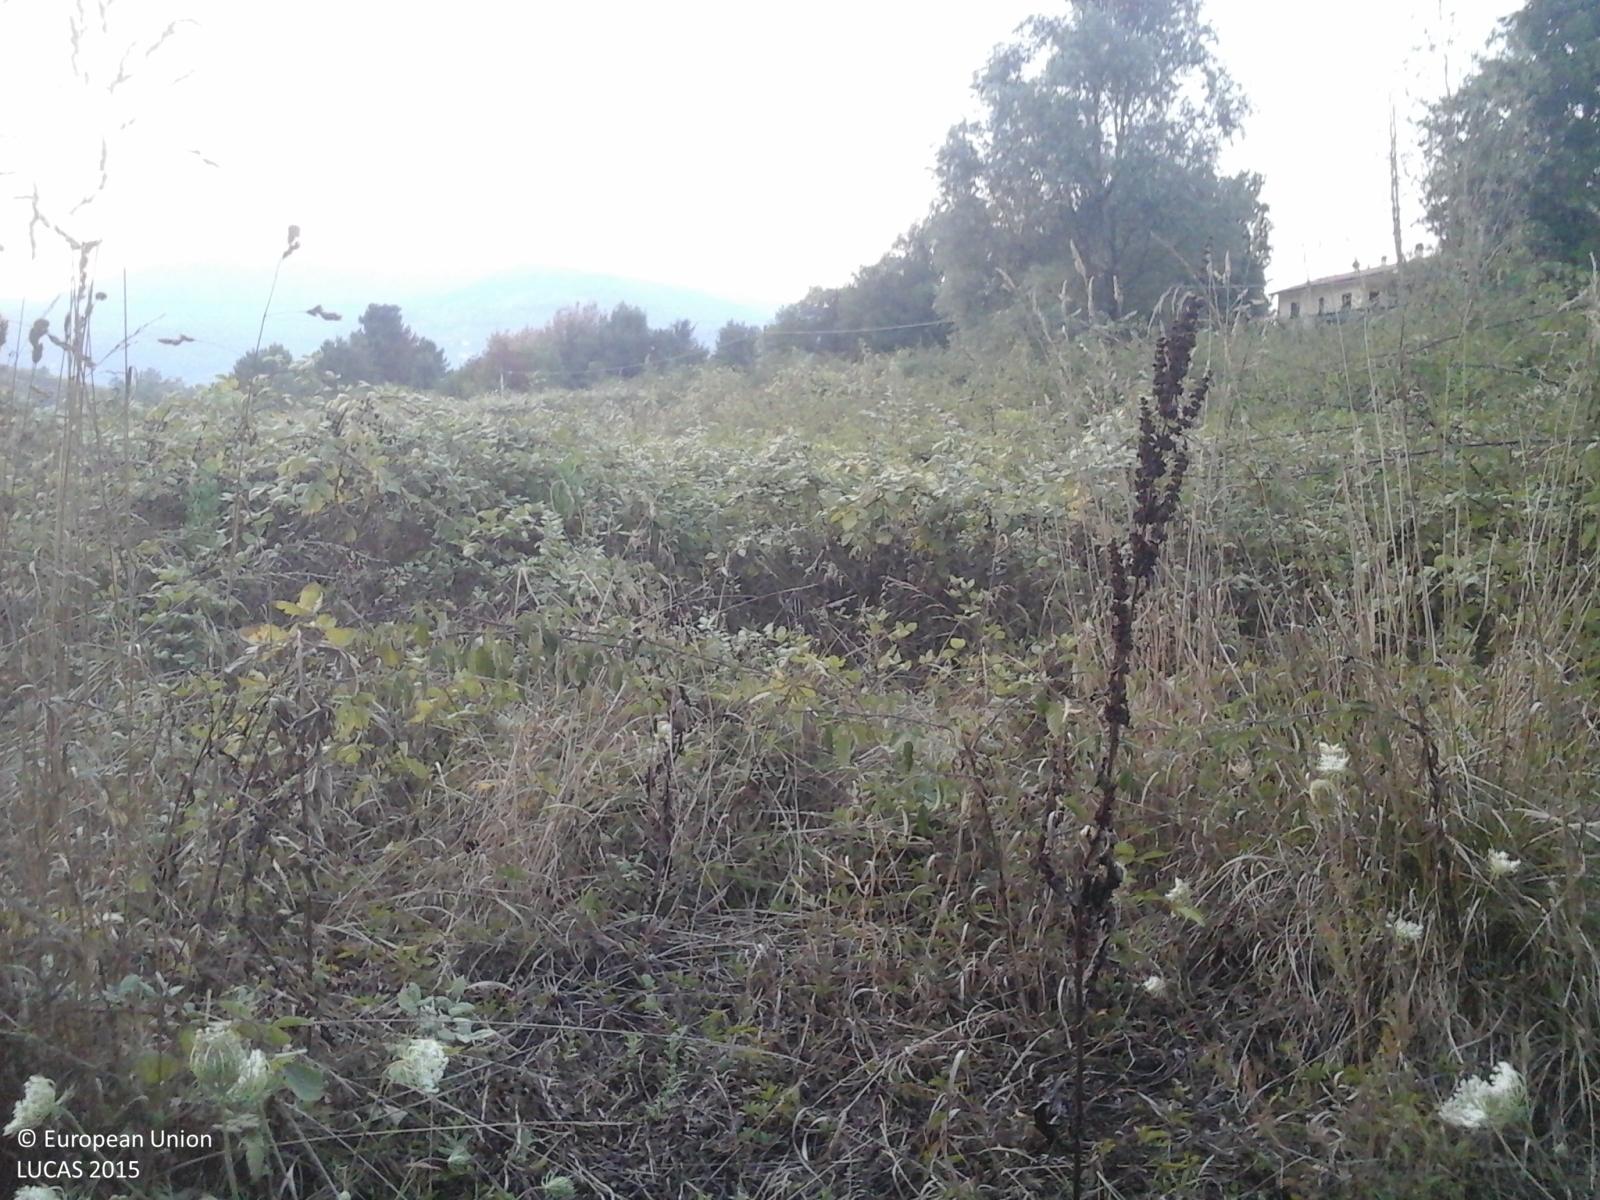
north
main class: Woodland
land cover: Broadleaved woodland
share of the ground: > 75 %
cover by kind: broadleaved forest trees 100 %
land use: Forestry
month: August
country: IT
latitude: 43.8794
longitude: 10.6579
